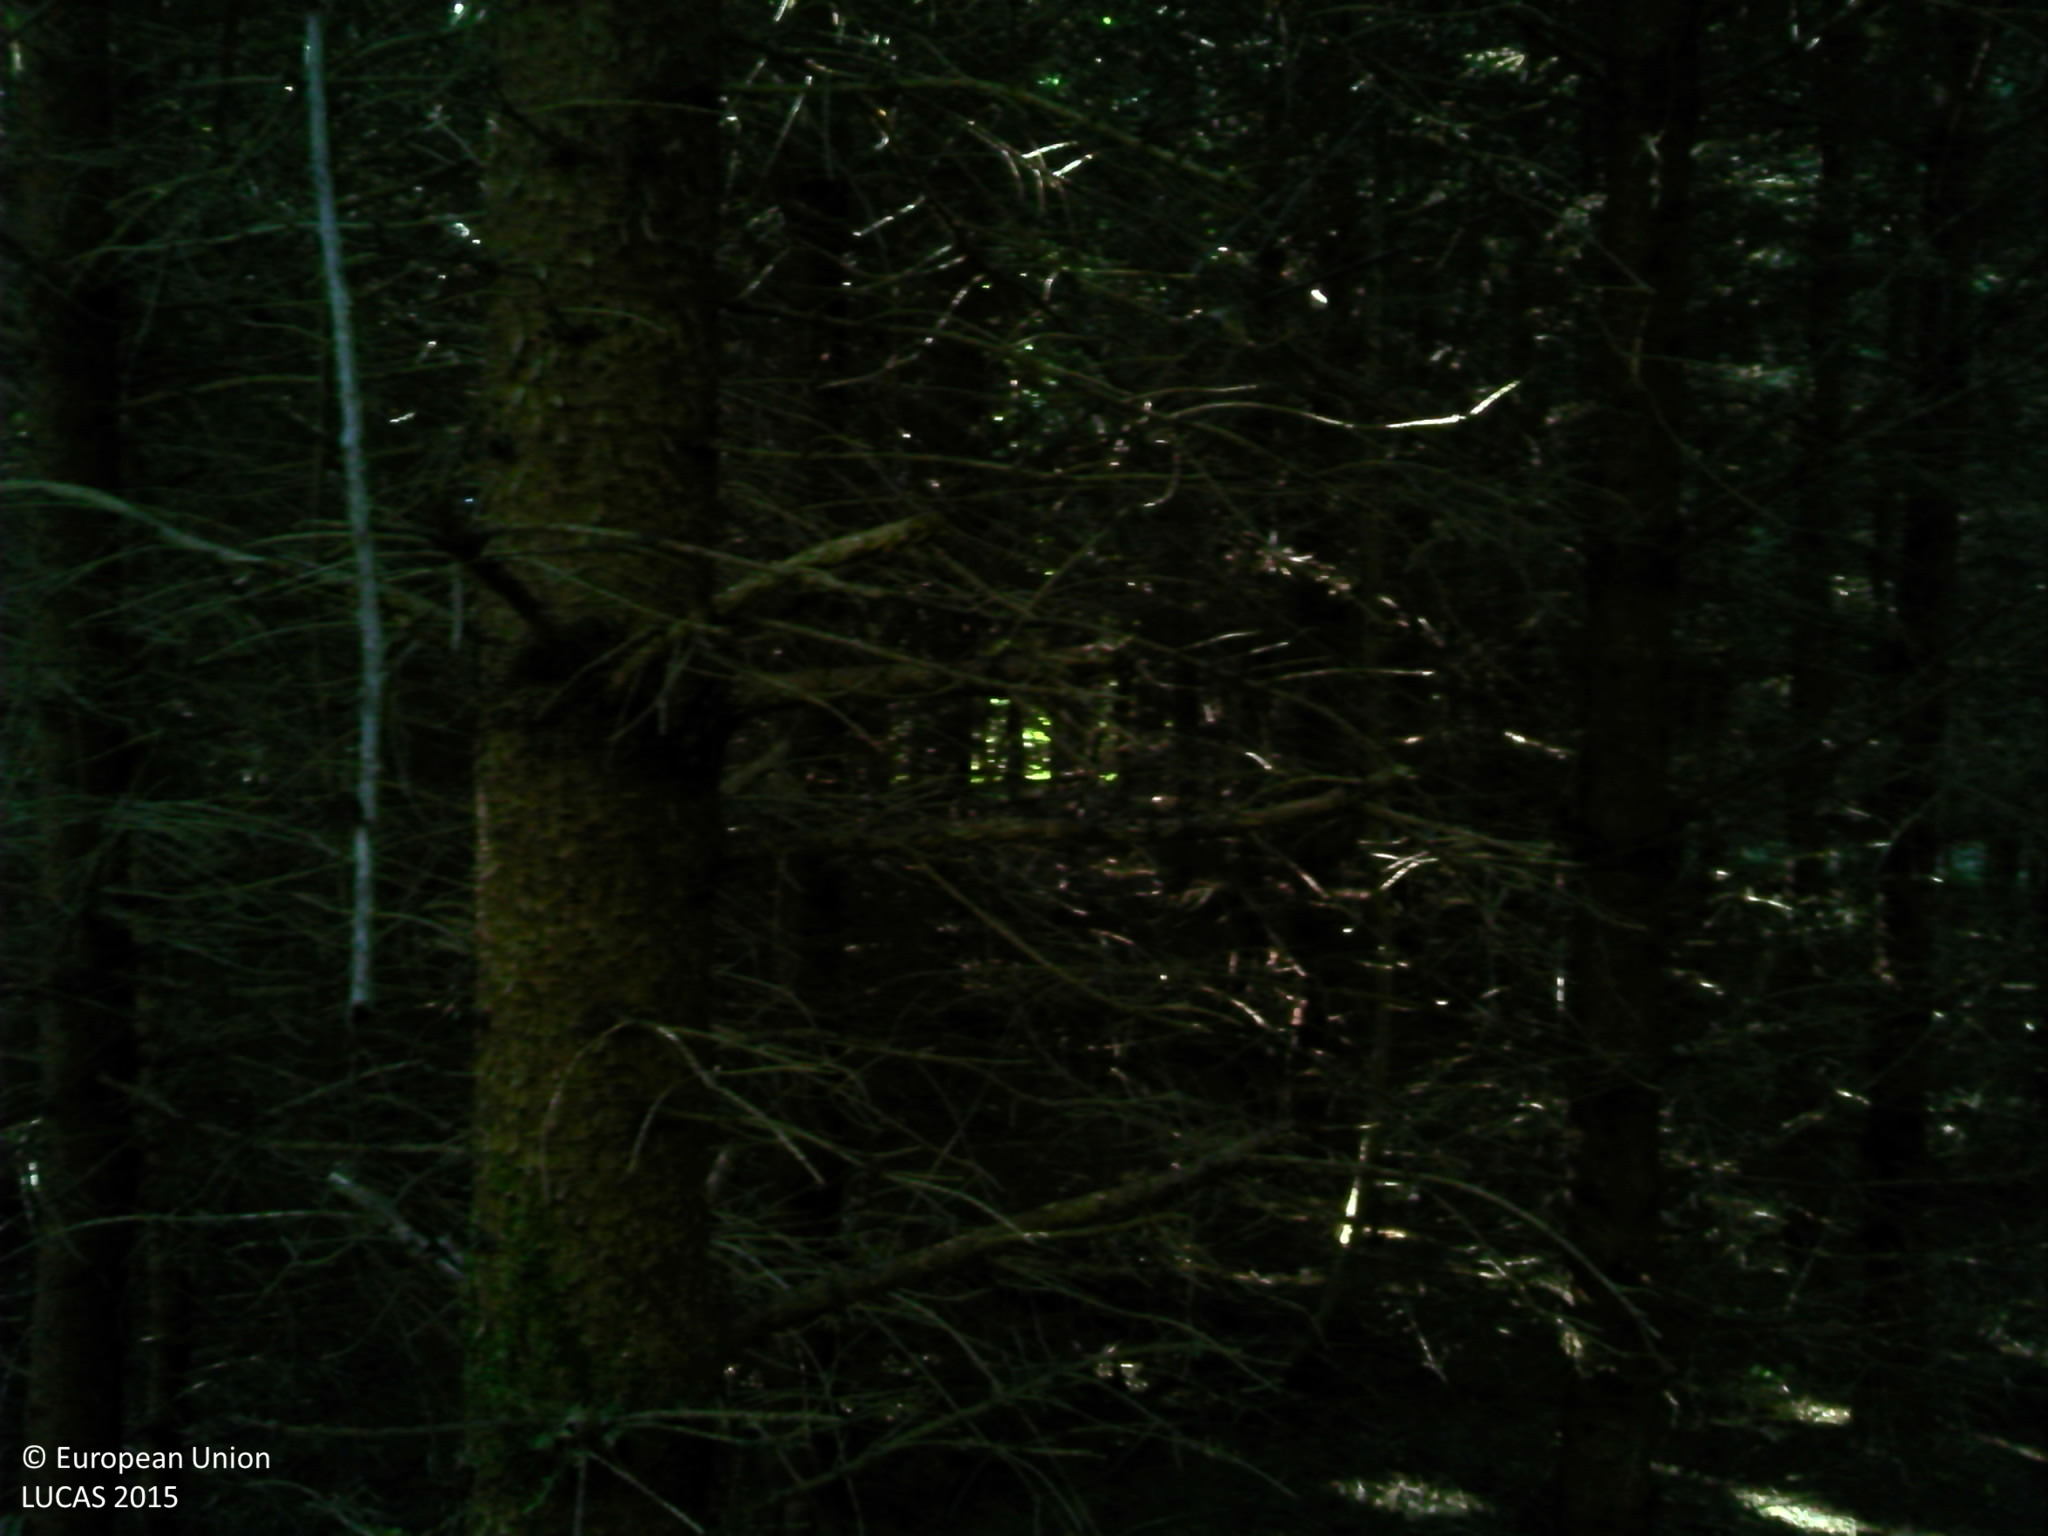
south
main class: Woodland
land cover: Spruce dominated coniferous woodland
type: alpine coniferous forest
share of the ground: > 75 %
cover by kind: coniferous forest trees 70 %, herbaceous plants 20 %, shrubs 10 %
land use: Forestry
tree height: > 5 m
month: September
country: FR
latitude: 47.2243
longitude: 6.2909
